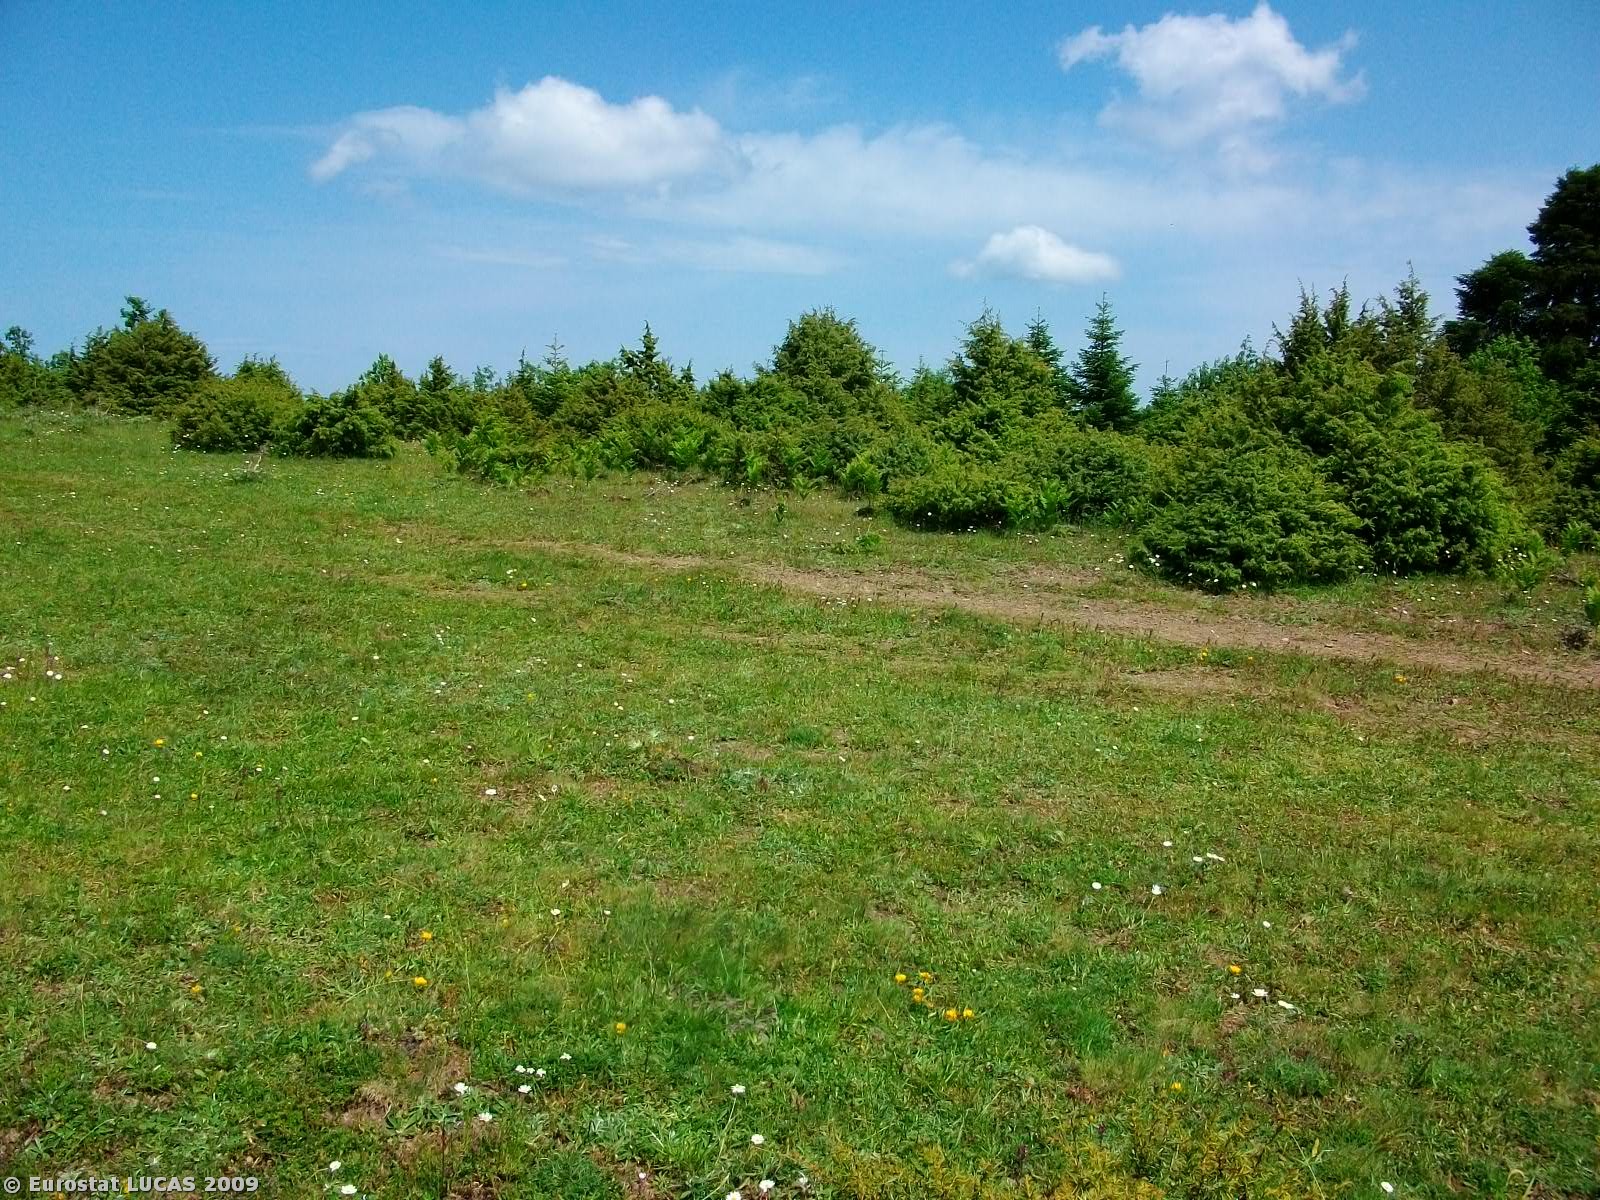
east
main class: Grassland
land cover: Grassland with sparse tree/shrub cover
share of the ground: > 75 %
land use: Agriculture (excluding fallow land and kitchen gardens)
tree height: < 5 m
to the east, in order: Grassland with sparse tree/shrub cover; Coniferous woodland; Ditches and canals; Mixed woodland
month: May
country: GR
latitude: 39.0501
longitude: 22.7303
